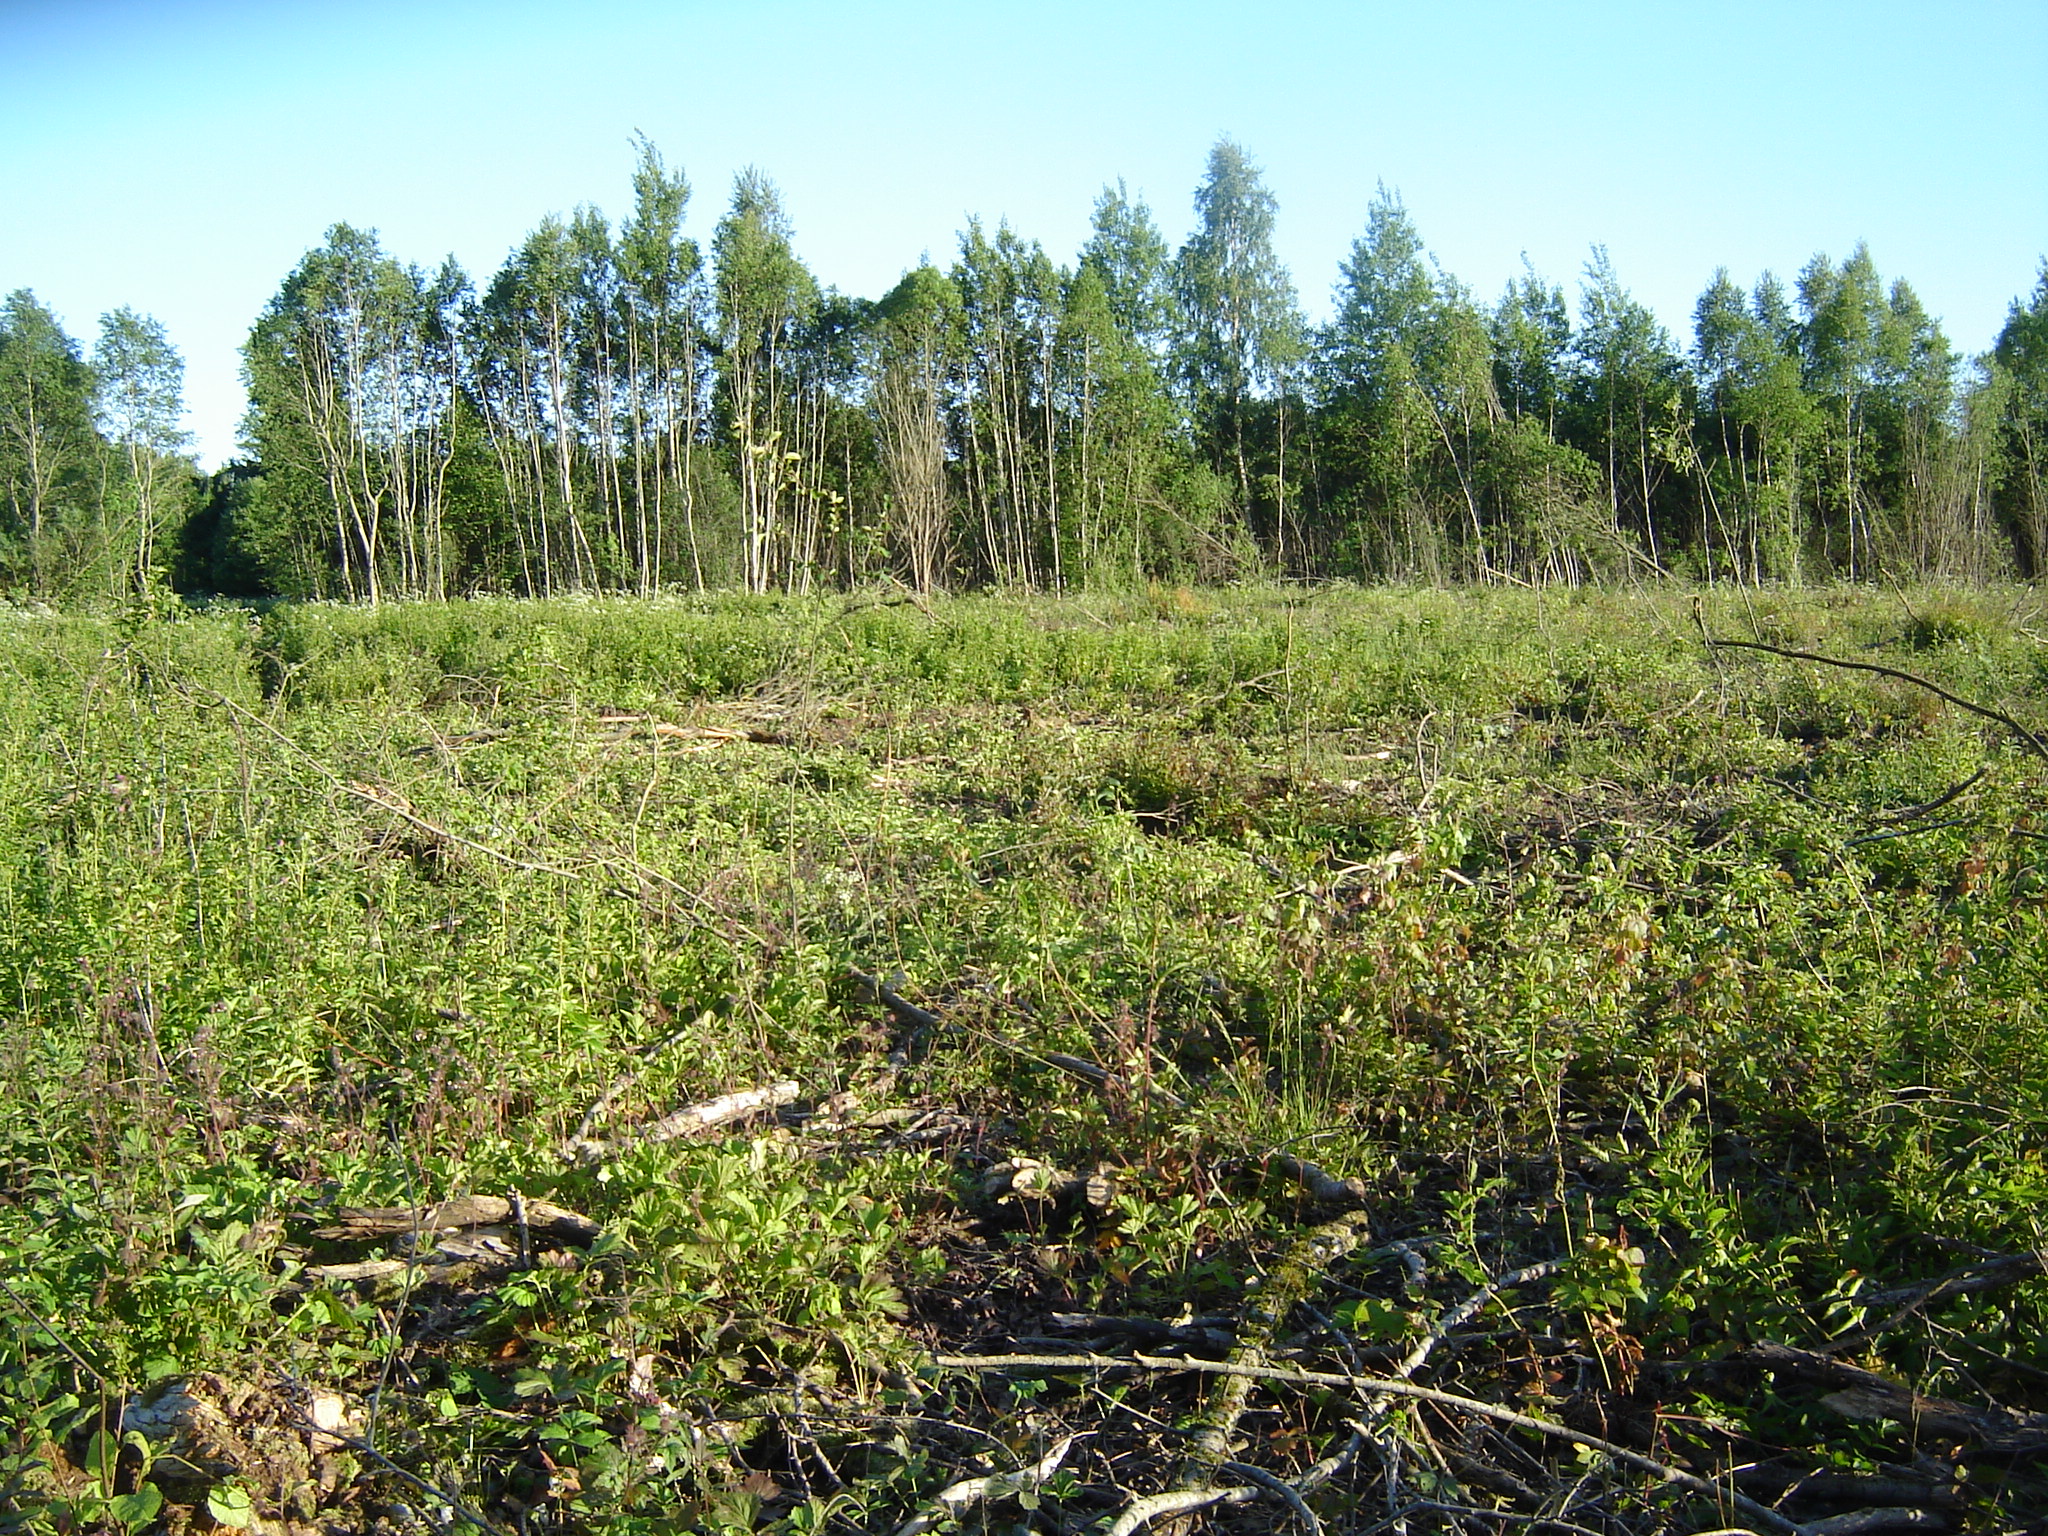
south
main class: Woodland
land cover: Broadleaved woodland
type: mire and swamp forests
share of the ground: > 75 %
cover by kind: broadleaved forest trees 75 %, shrubs 15 %, herbaceous plants 10 %
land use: Forestry
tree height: < 5 m
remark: Clear cut
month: June
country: LT
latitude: 55.5500
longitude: 24.7356
